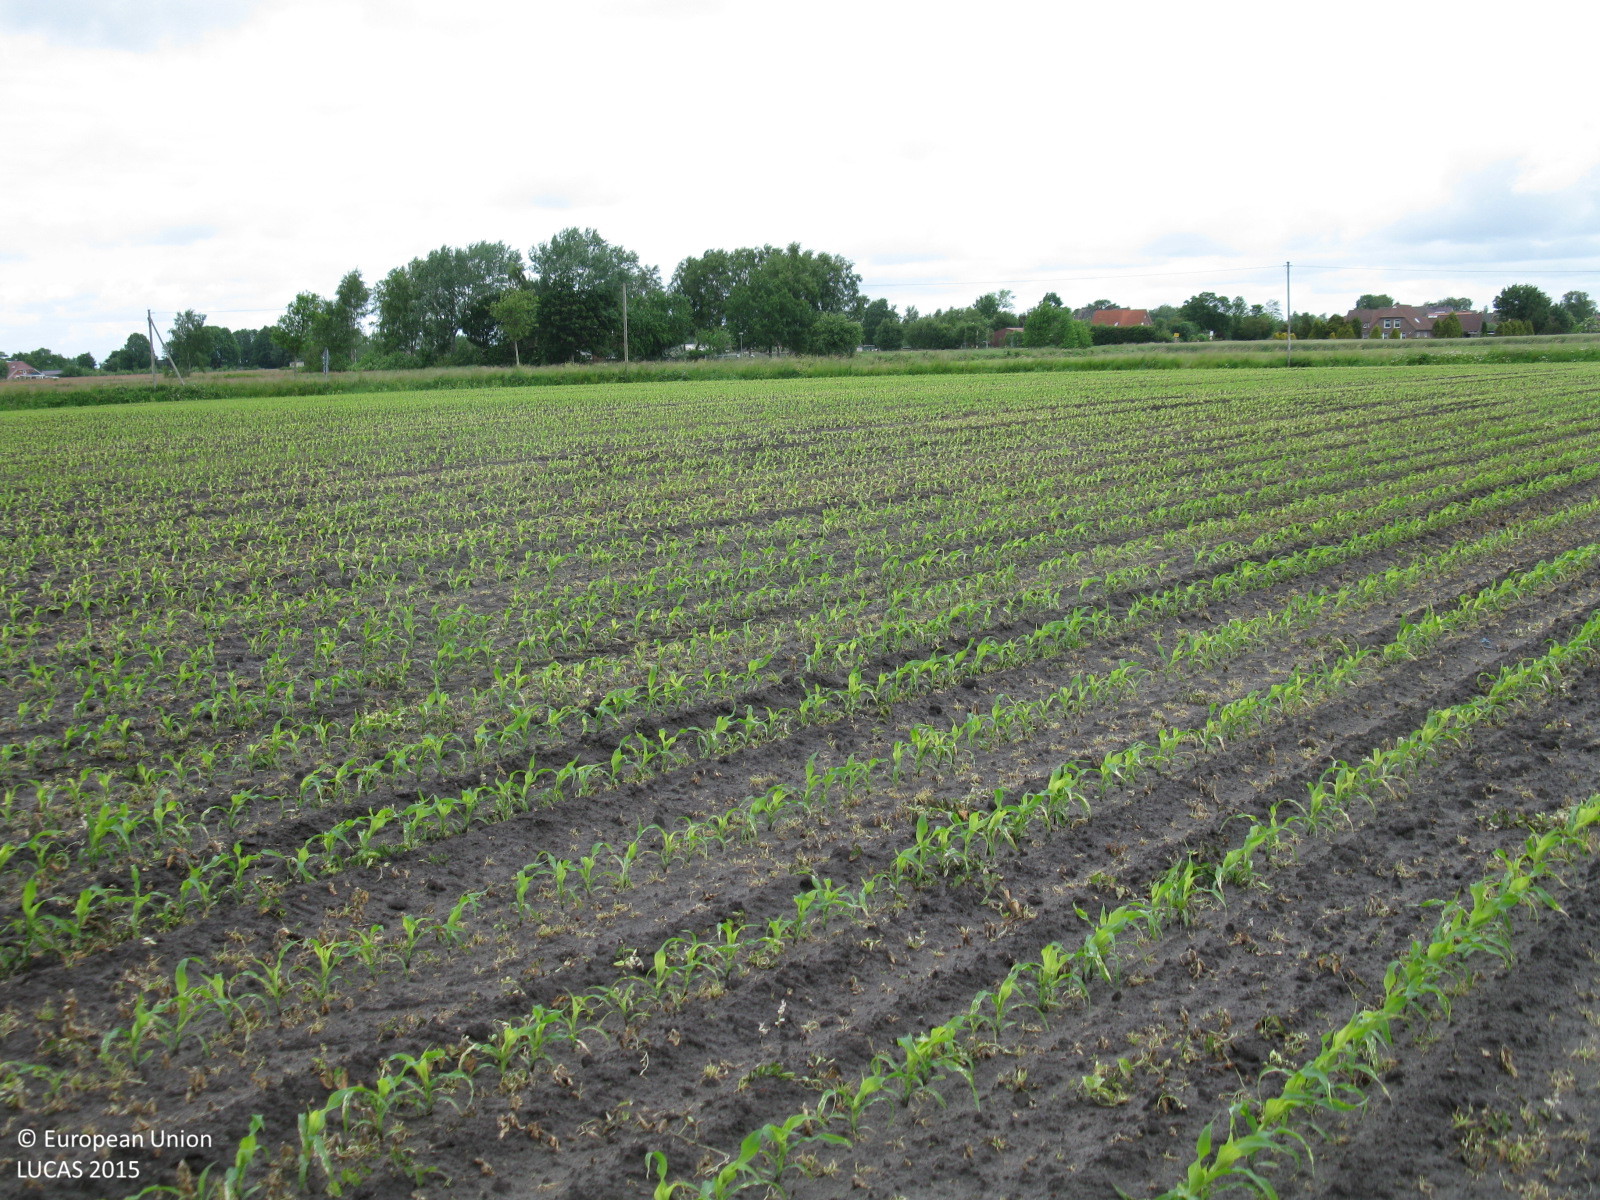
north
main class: Cropland
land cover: Maize
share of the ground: 10 - 25 %
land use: Agriculture (excluding fallow land and kitchen gardens)
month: June
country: DE
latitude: 53.4452
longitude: 7.3658
